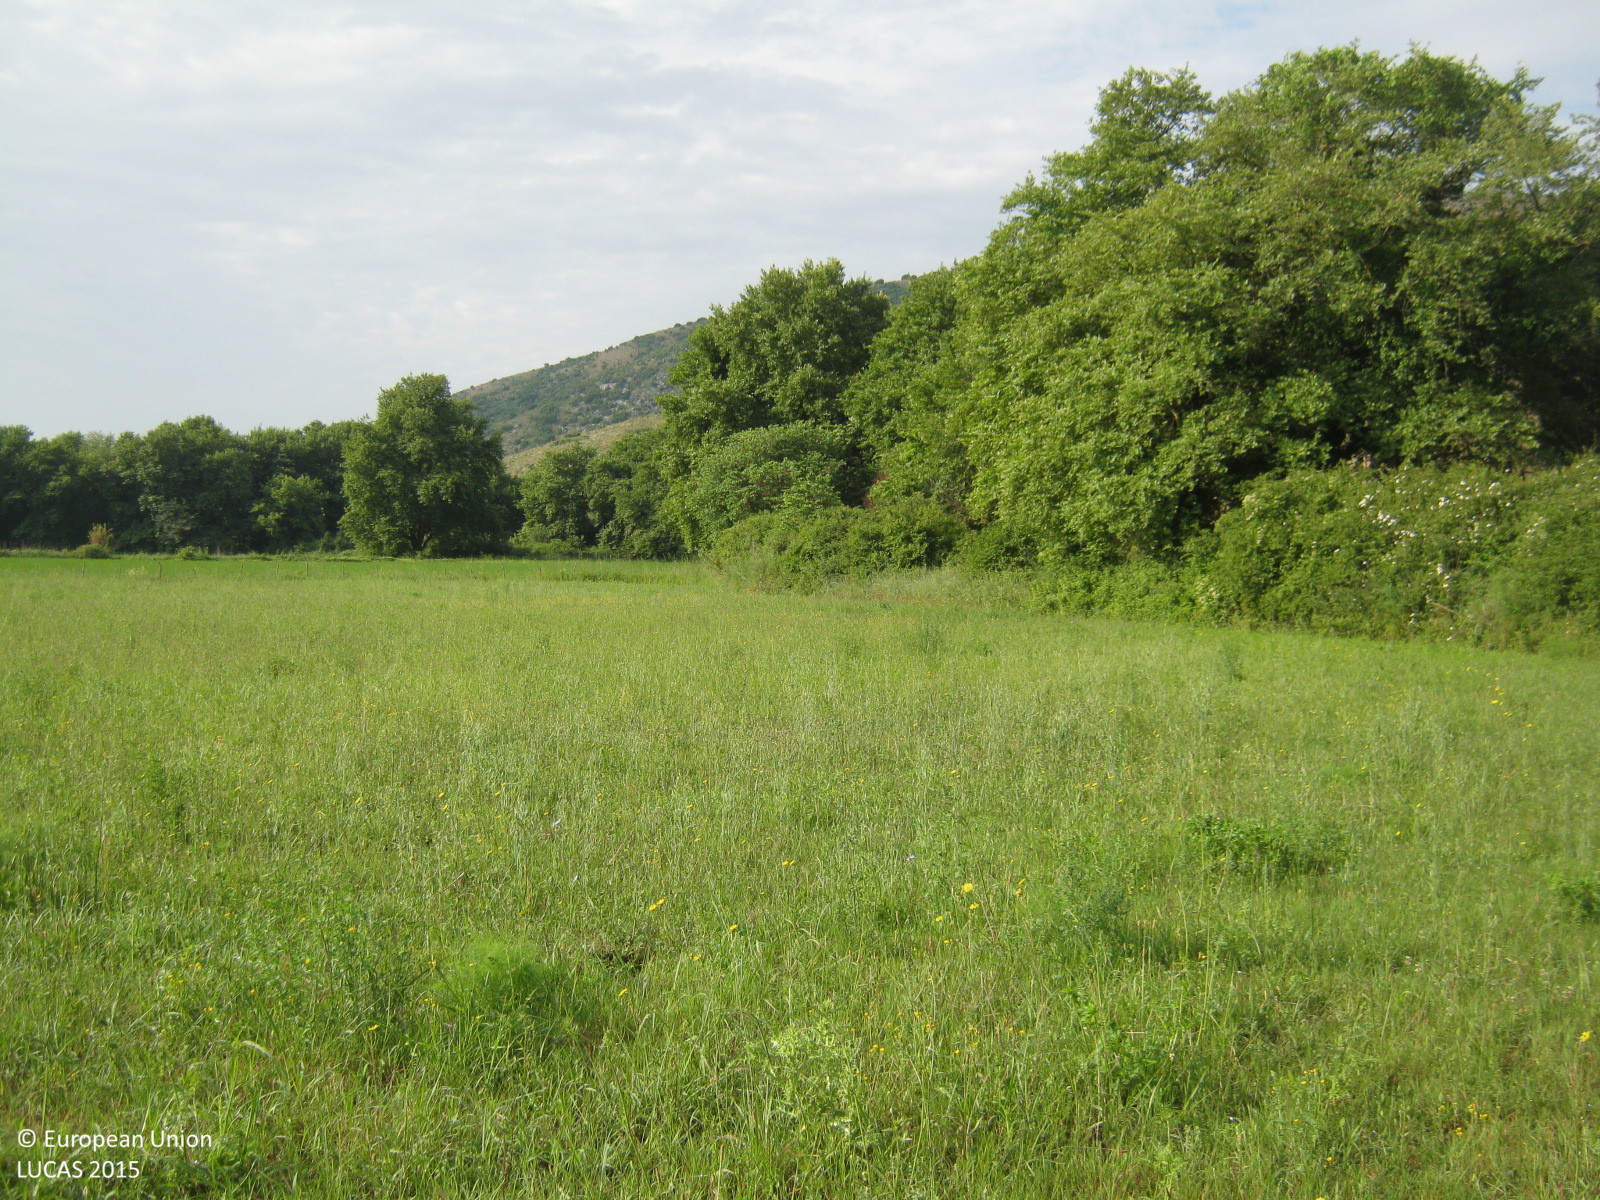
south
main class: Cropland
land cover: Lucerne
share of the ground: > 75 %
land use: Agriculture (excluding fallow land and kitchen gardens)
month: June
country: GR
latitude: 39.3892
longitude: 20.5279
